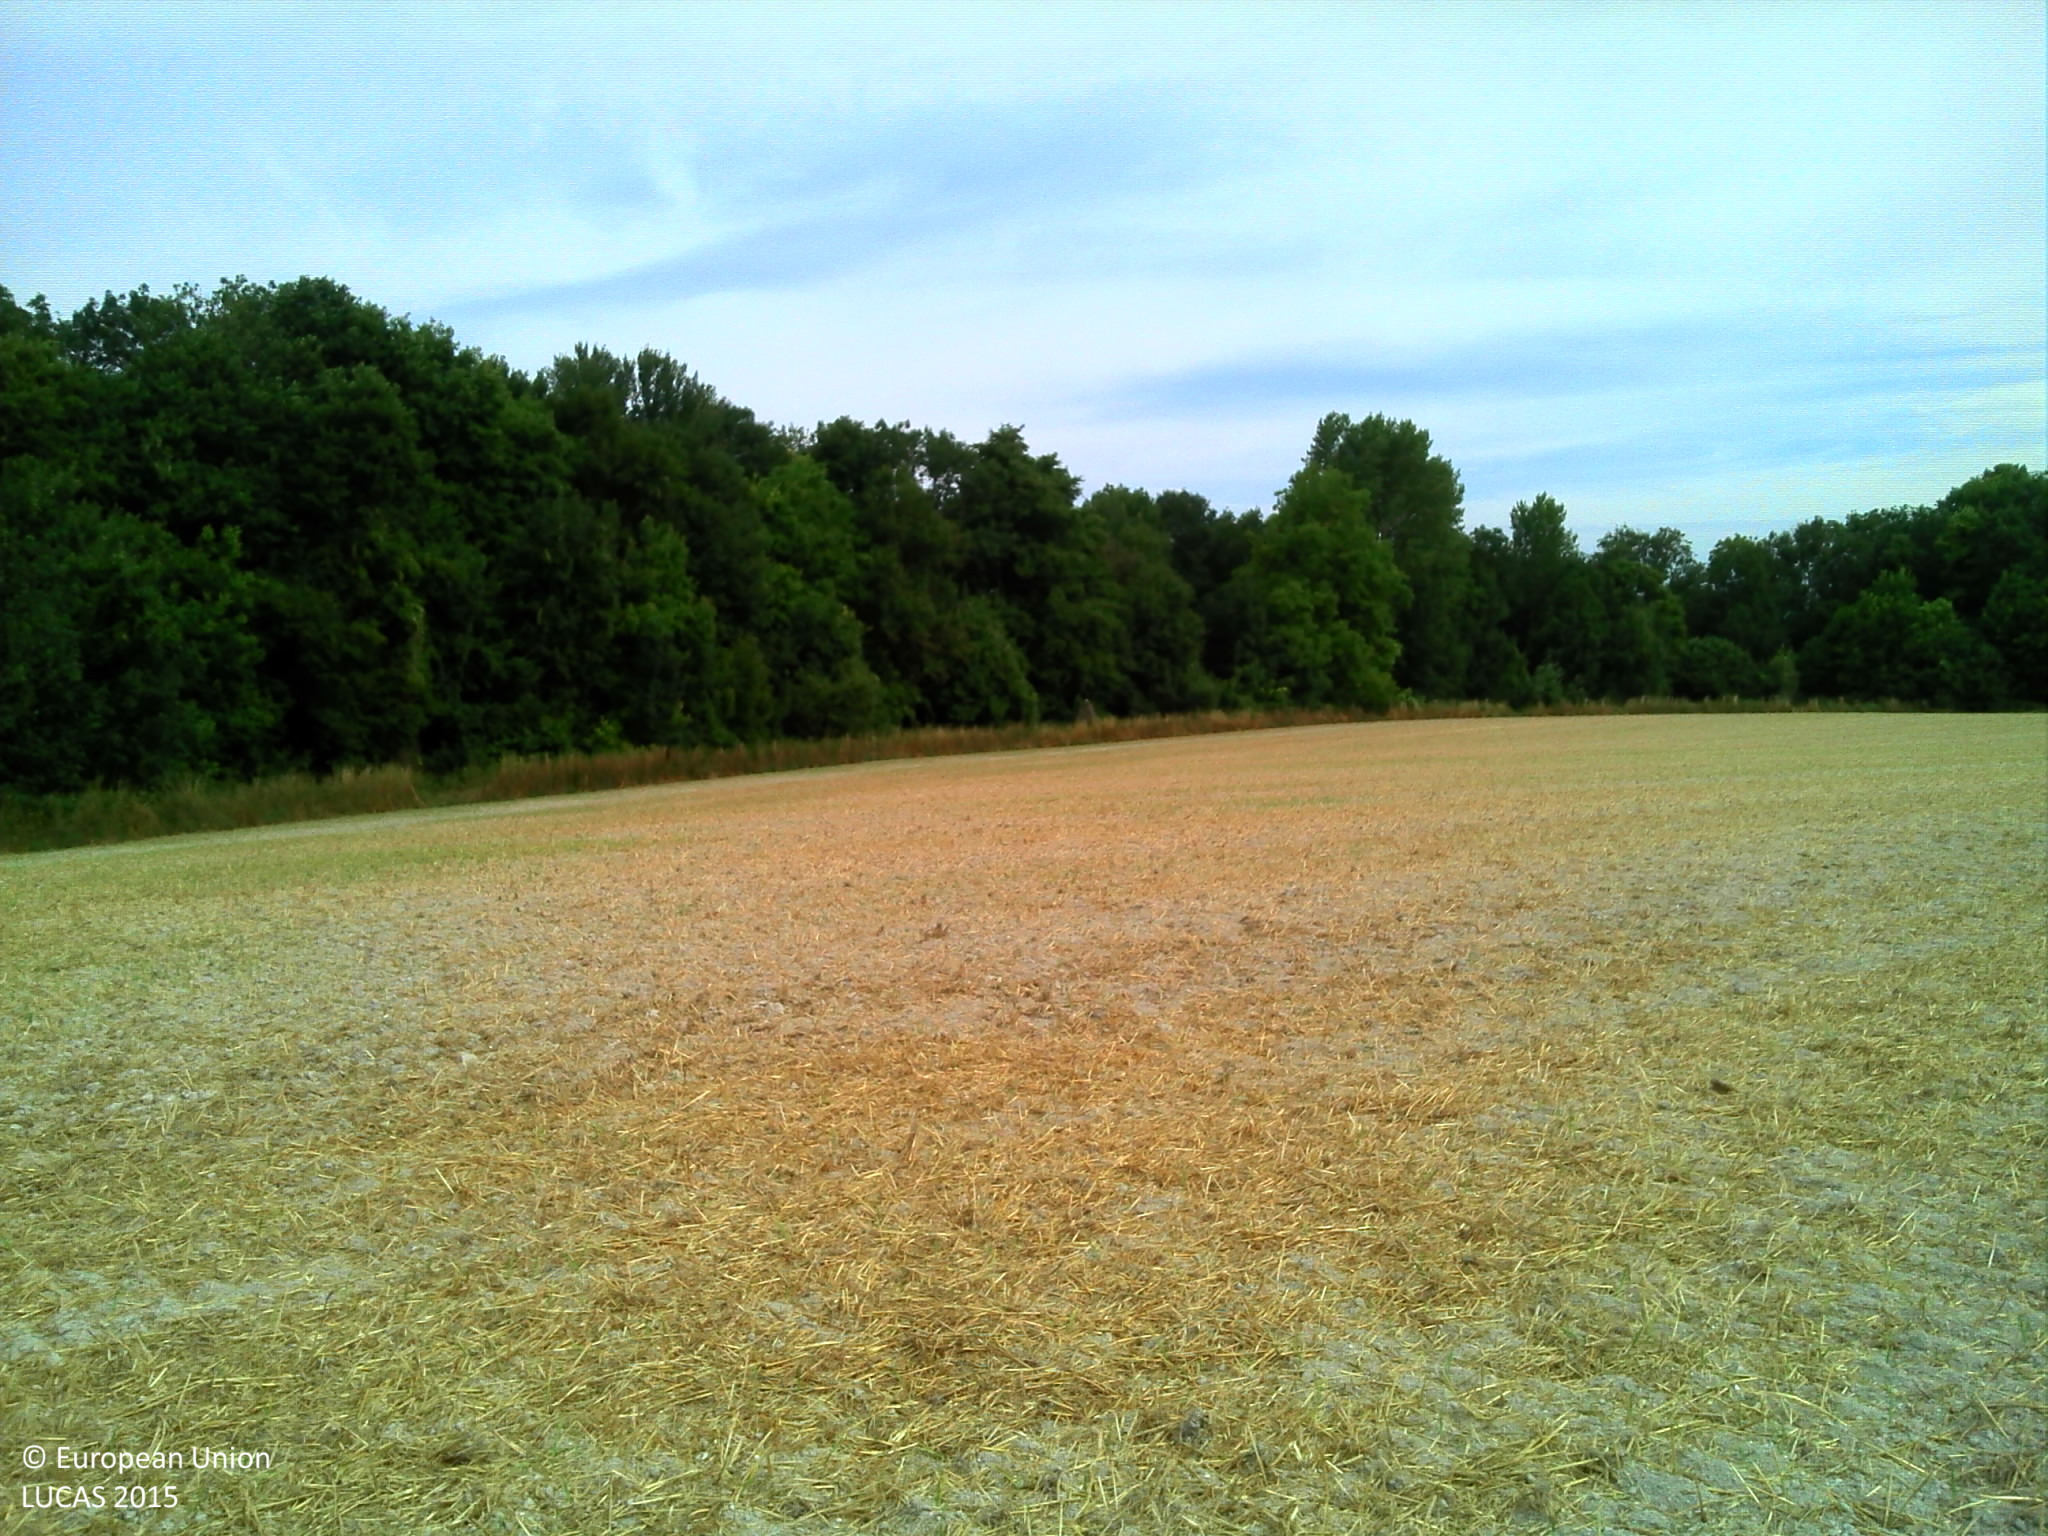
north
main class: Cropland
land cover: Barley
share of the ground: > 75 %
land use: Agriculture (excluding fallow land and kitchen gardens)
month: July
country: FR
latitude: 48.8439
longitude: 4.1501
